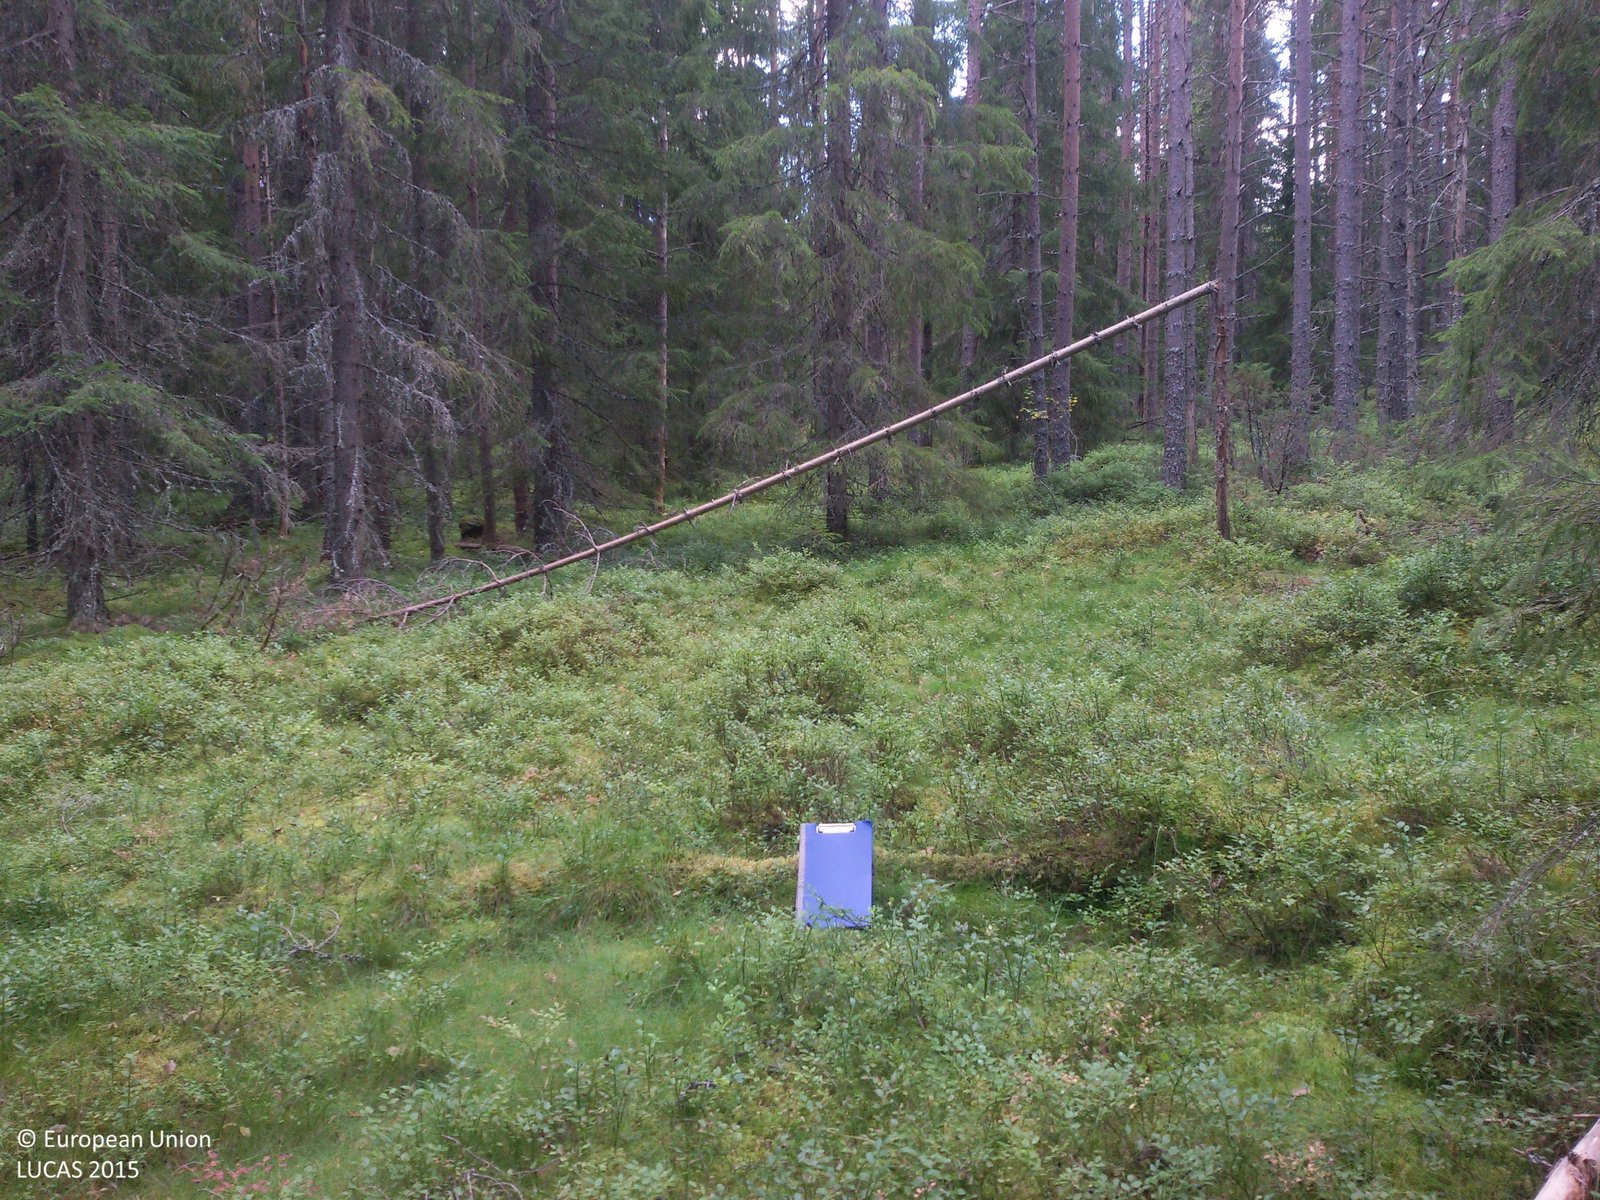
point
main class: Woodland
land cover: Pine dominated coniferous woodland
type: boreal forest
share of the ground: 50 - 75 %
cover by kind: coniferous forest trees 60 %, shrubs 20 %, herbaceous plants 10 %, lichens and mosses 10 %
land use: Forestry
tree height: > 5 m
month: August
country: SE
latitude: 60.7977
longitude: 15.4438
